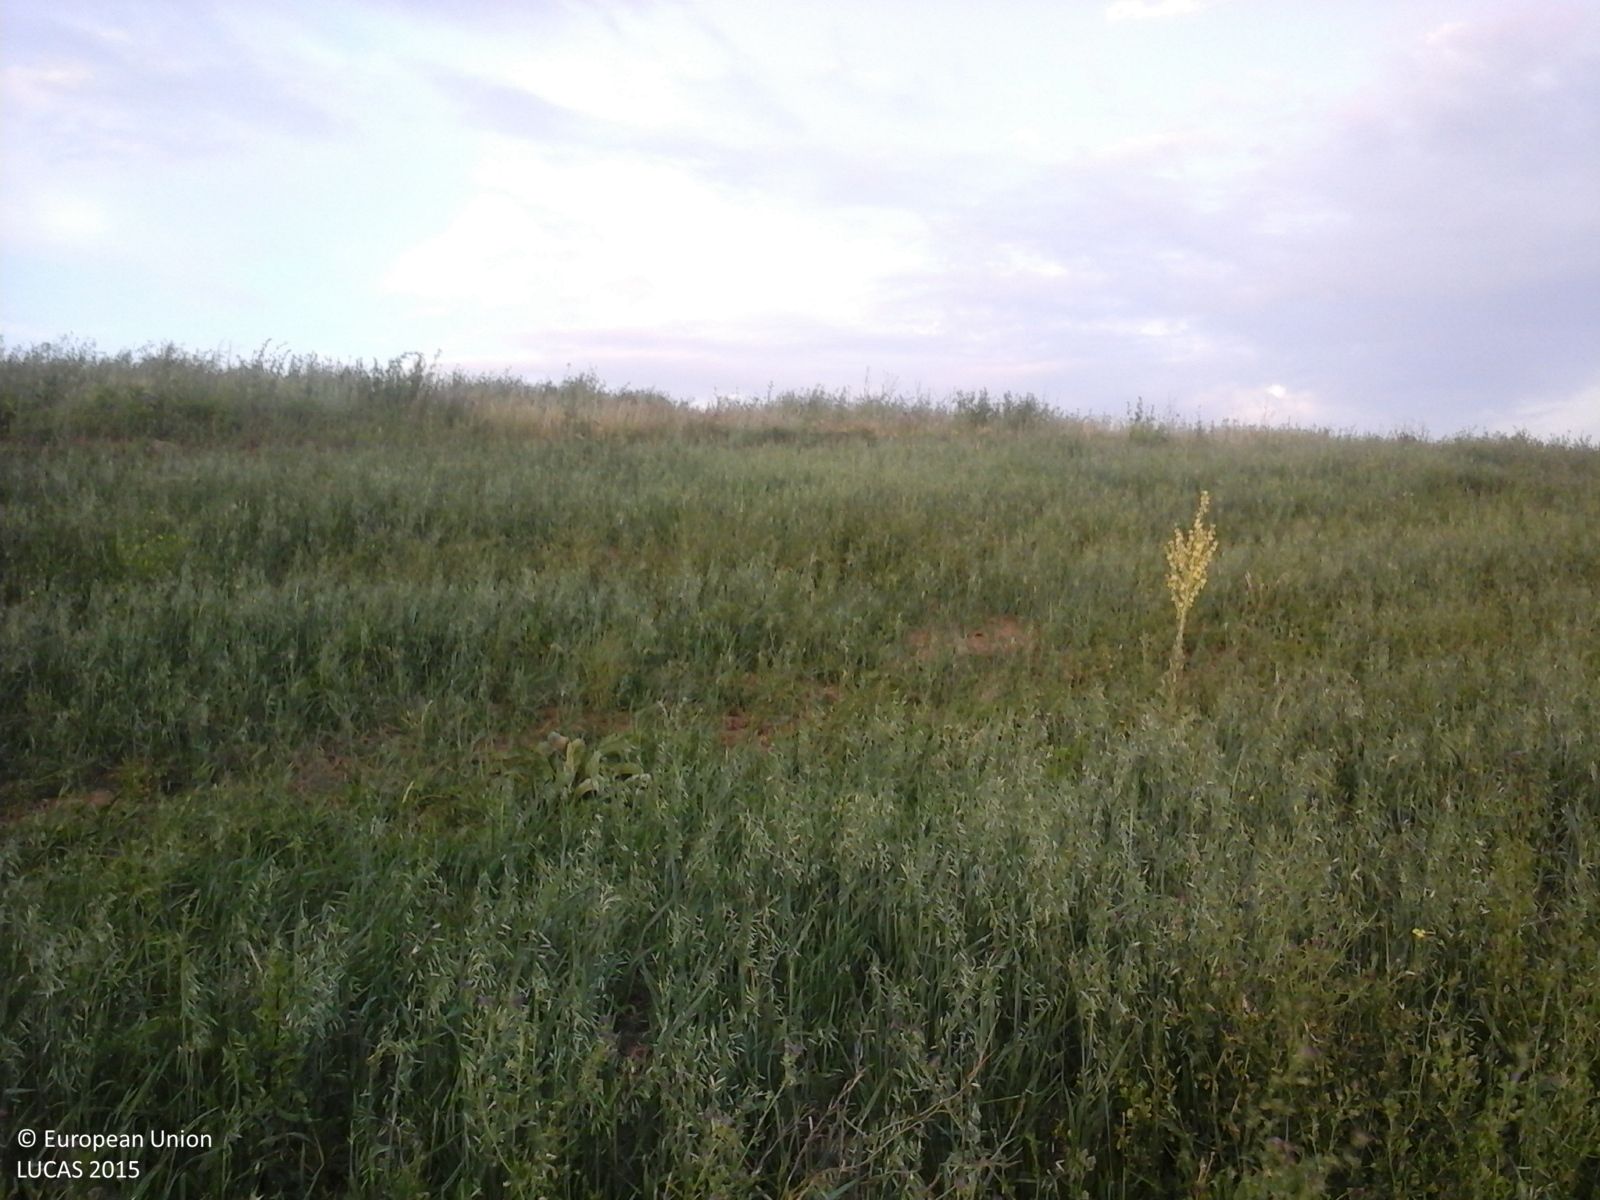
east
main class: Cropland
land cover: Oats
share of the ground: > 75 %
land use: Agriculture (excluding fallow land and kitchen gardens)
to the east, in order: Oats; Spontaneously vegetated surfaces; Lucerne; Spontaneously vegetated surfaces; Tracks; Spontaneously vegetated surfaces; Sunflower; Grassland without tree/shrub cover
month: June
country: RO
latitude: 46.6822
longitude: 27.4870
